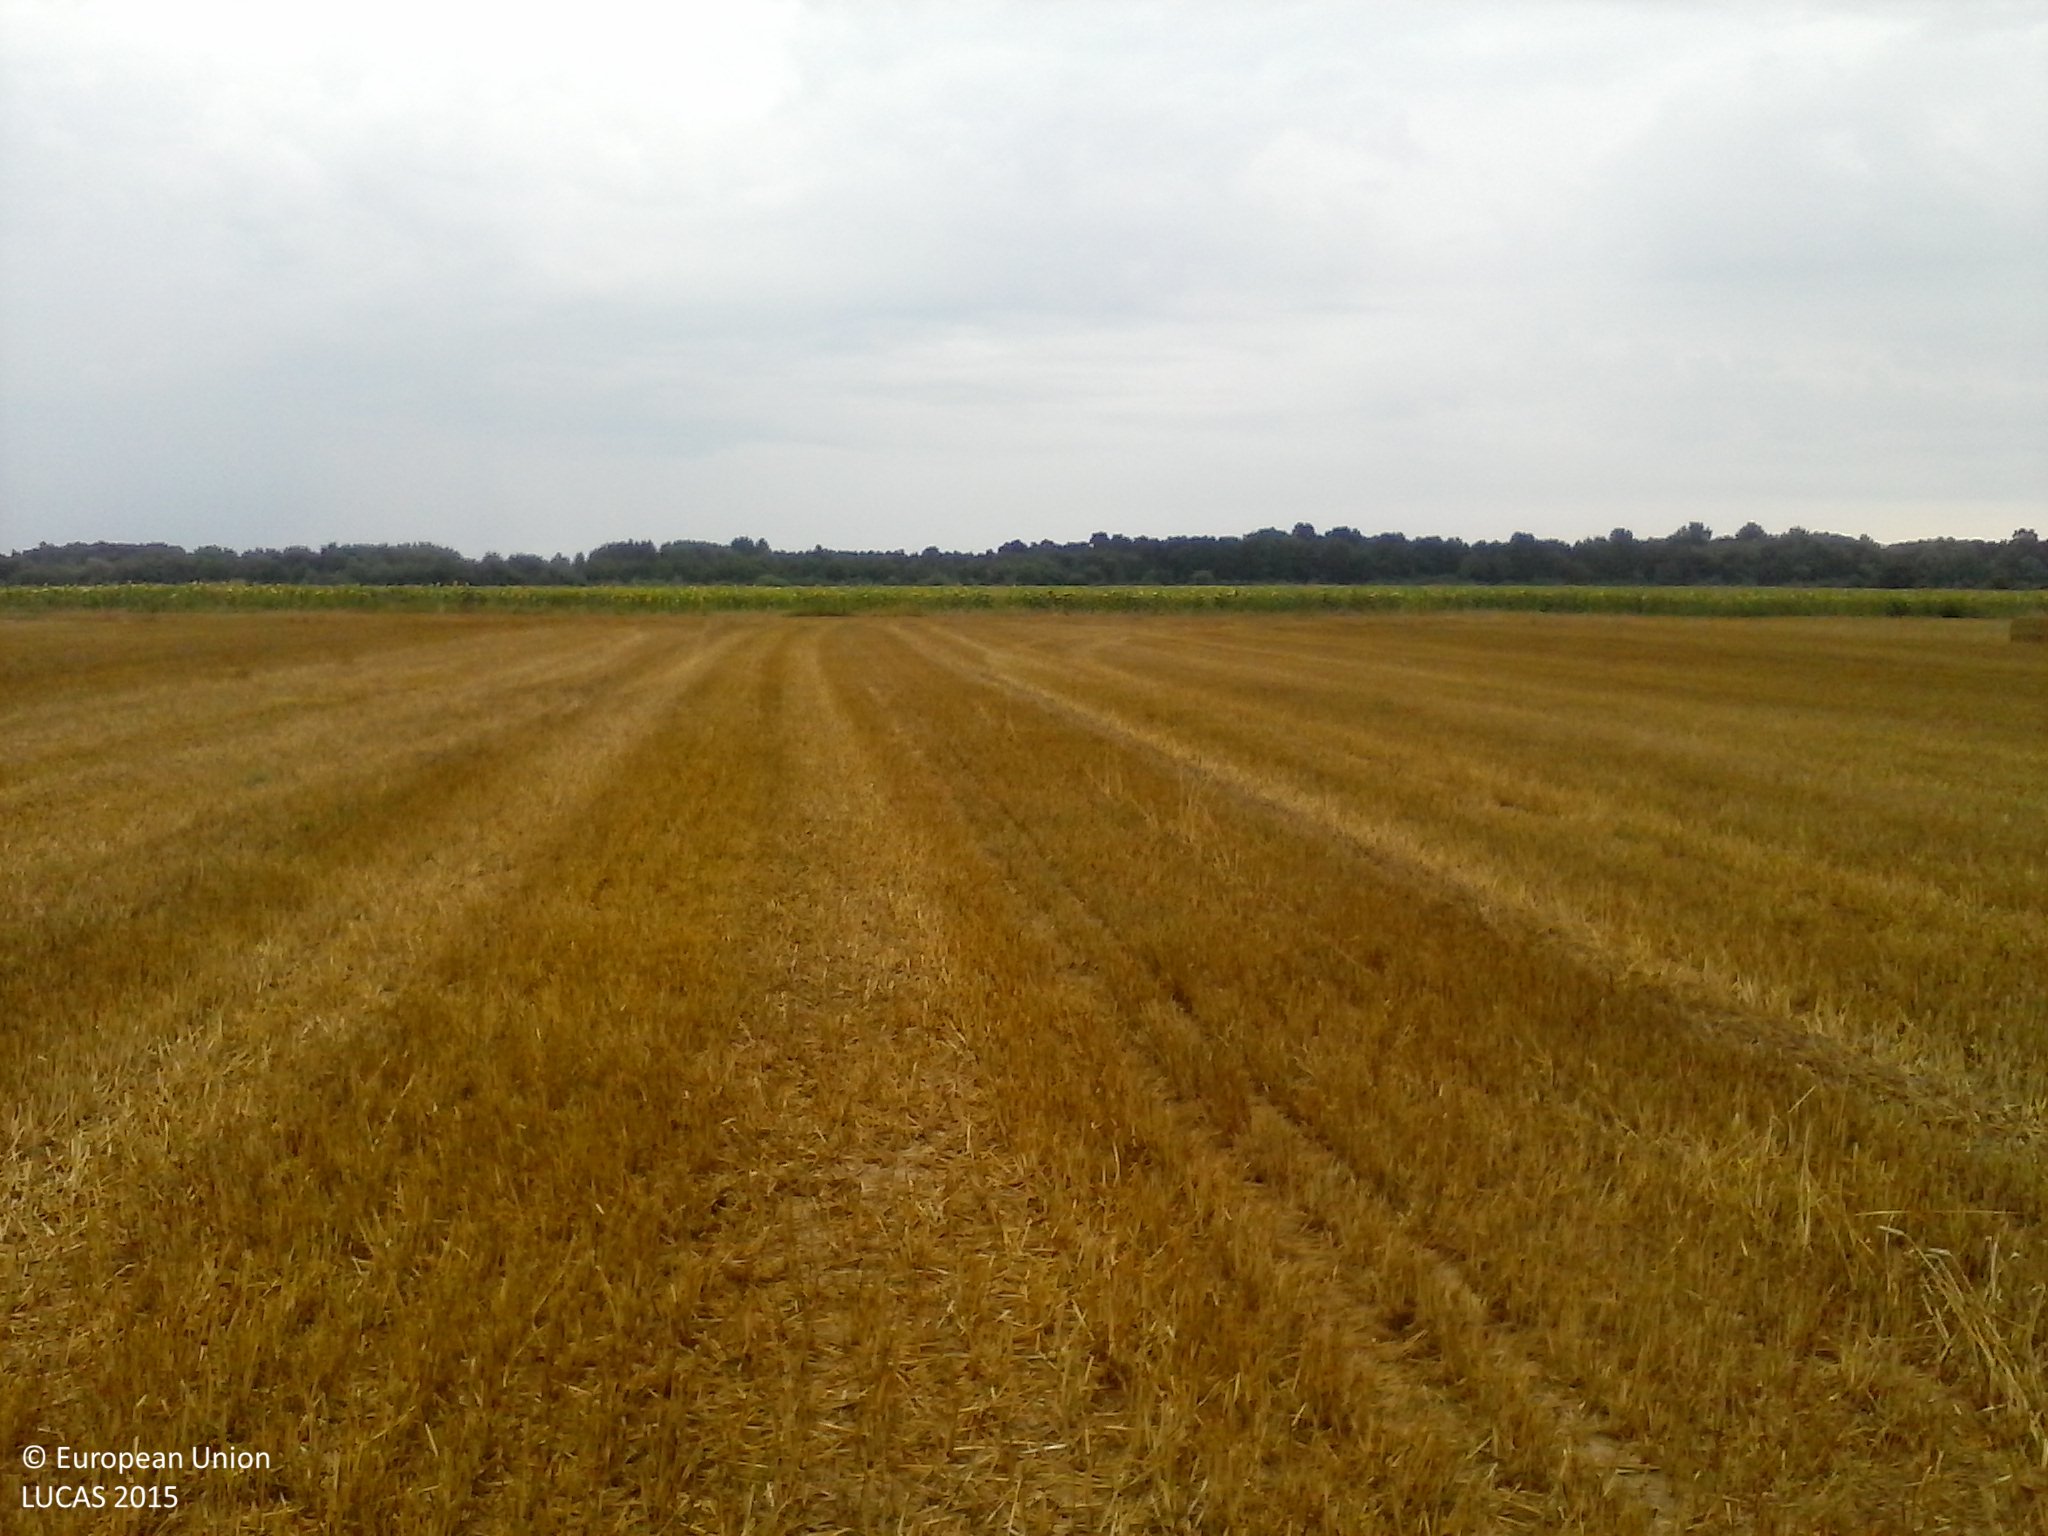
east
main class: Cropland
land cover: Durum wheat
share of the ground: > 75 %
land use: Agriculture (excluding fallow land and kitchen gardens)
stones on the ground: < 10 %
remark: Harvested field
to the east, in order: Durum wheat; Grass margins; Tracks; Grass margins; Sunflower
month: July
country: HU
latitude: 46.0396
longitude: 17.6667
